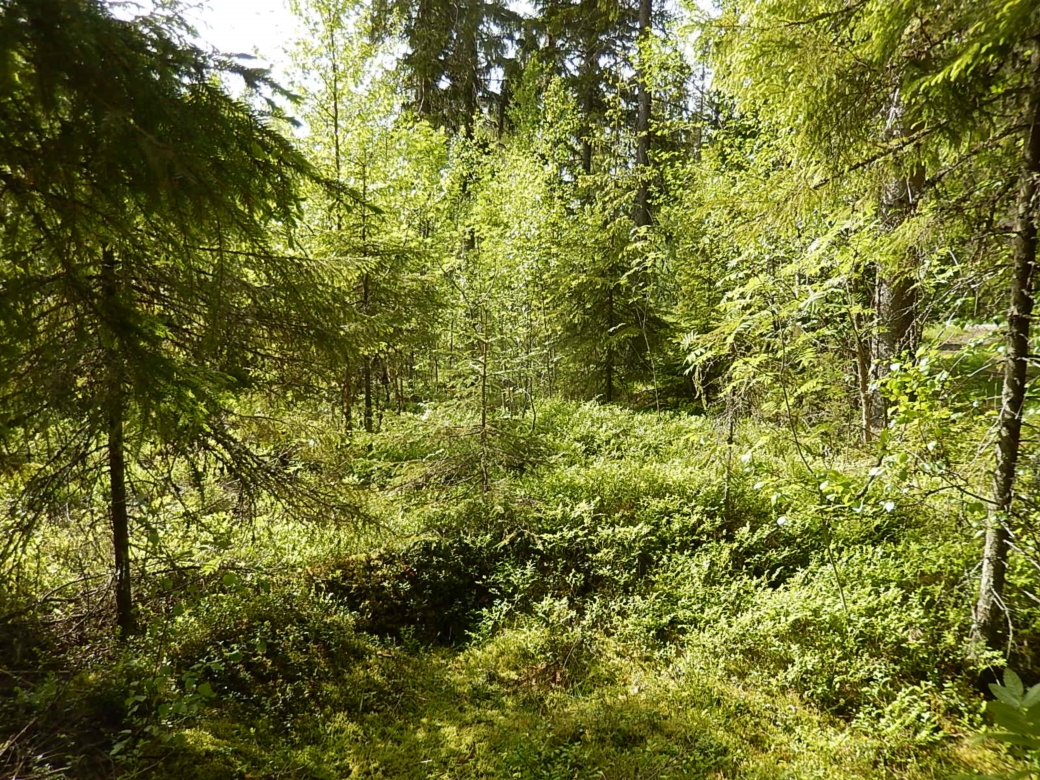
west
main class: Woodland
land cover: Spruce dominated coniferous woodland
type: boreal forest
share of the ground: > 75 %
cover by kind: coniferous forest trees 75 %, shrubs 15 %, broadleaved forest trees 10 %
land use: Forestry
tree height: > 5 m
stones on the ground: < 10 %
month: June
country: FI
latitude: 61.7944
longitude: 21.6383
